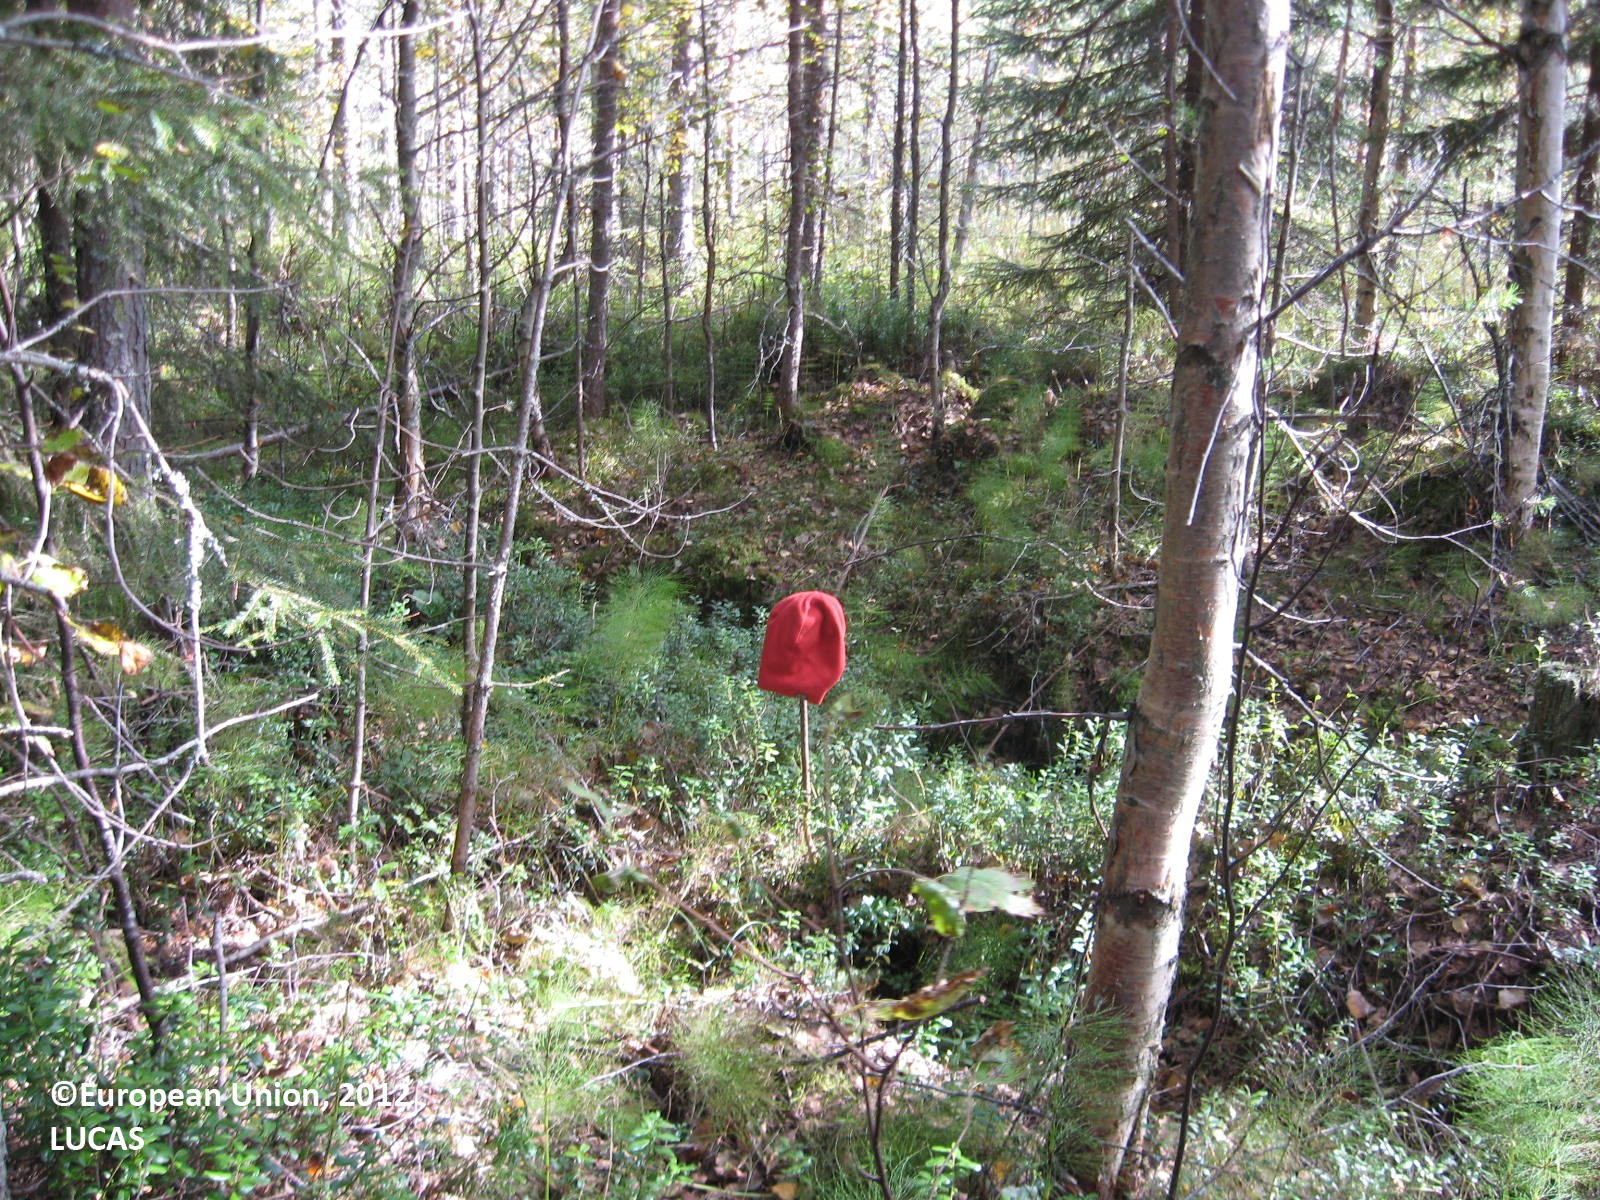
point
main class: Woodland
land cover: Other mixed woodland
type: boreal forest
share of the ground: > 75 %
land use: Forestry
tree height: > 5 m
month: August
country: FI
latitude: 63.9292
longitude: 30.1321
